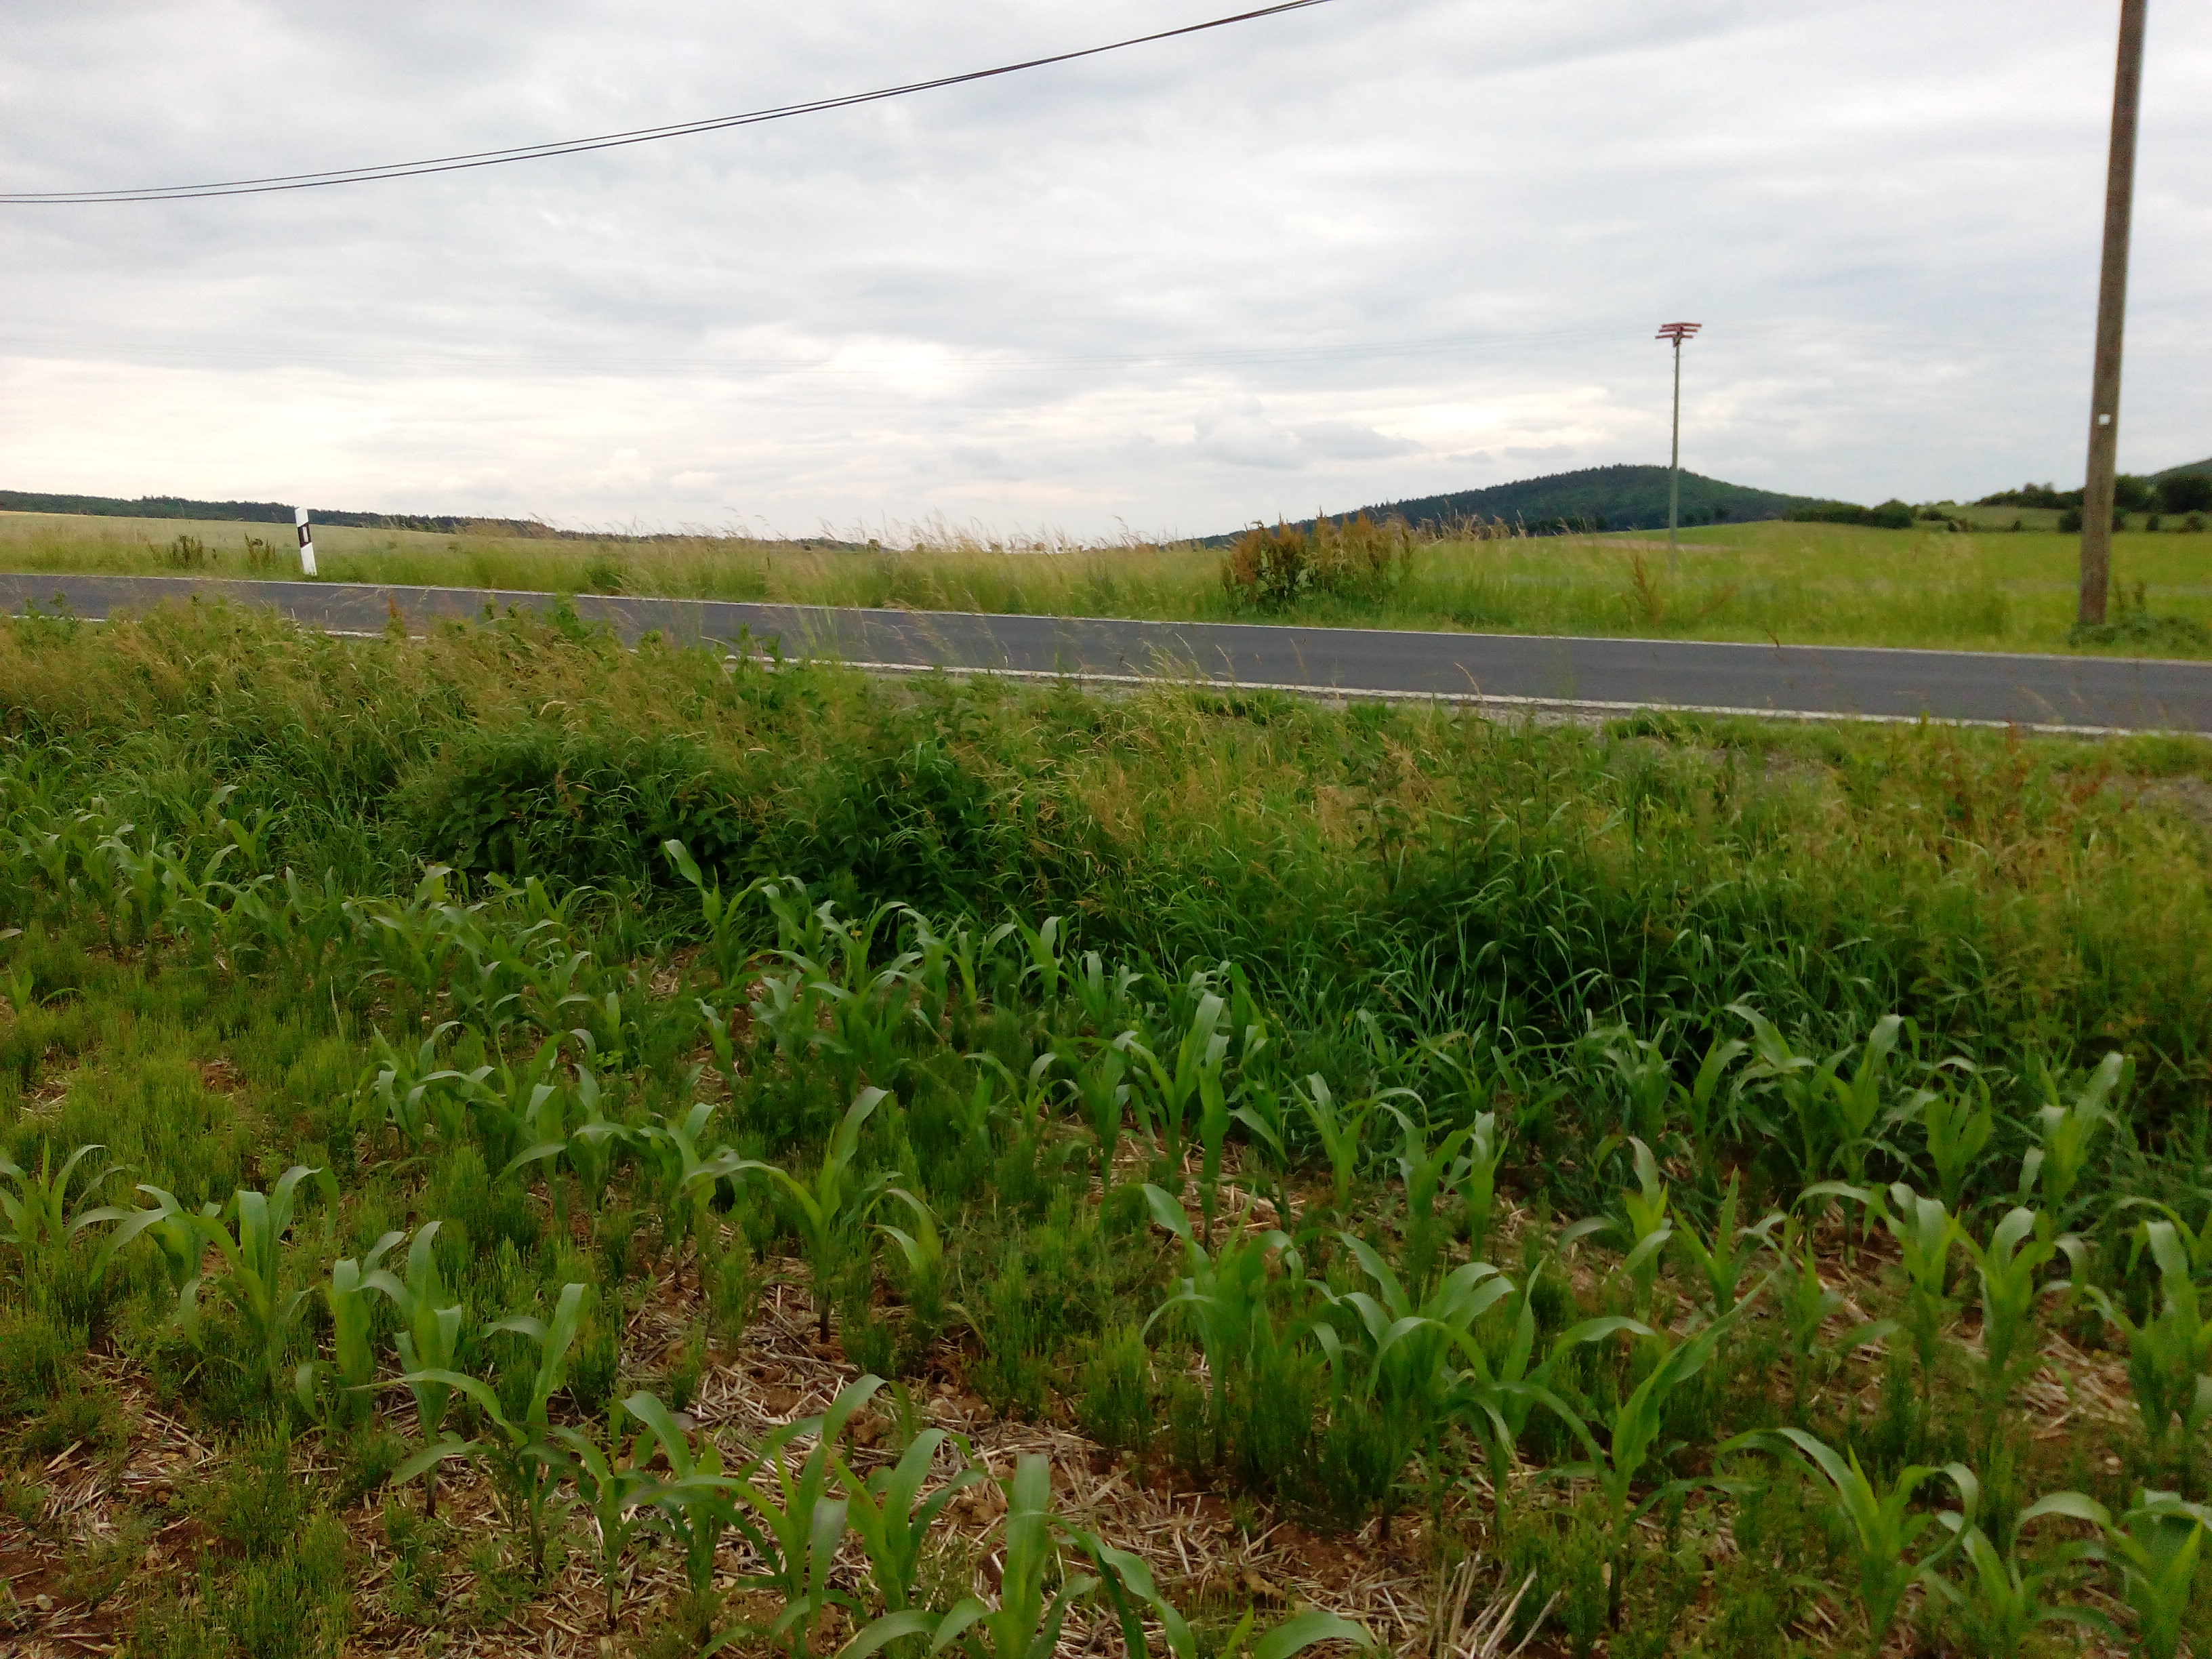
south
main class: Cropland
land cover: Maize
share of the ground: 25 - 50 %
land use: Agriculture (excluding fallow land and kitchen gardens)
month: June
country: DE
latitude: 50.4526
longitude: 10.5491
